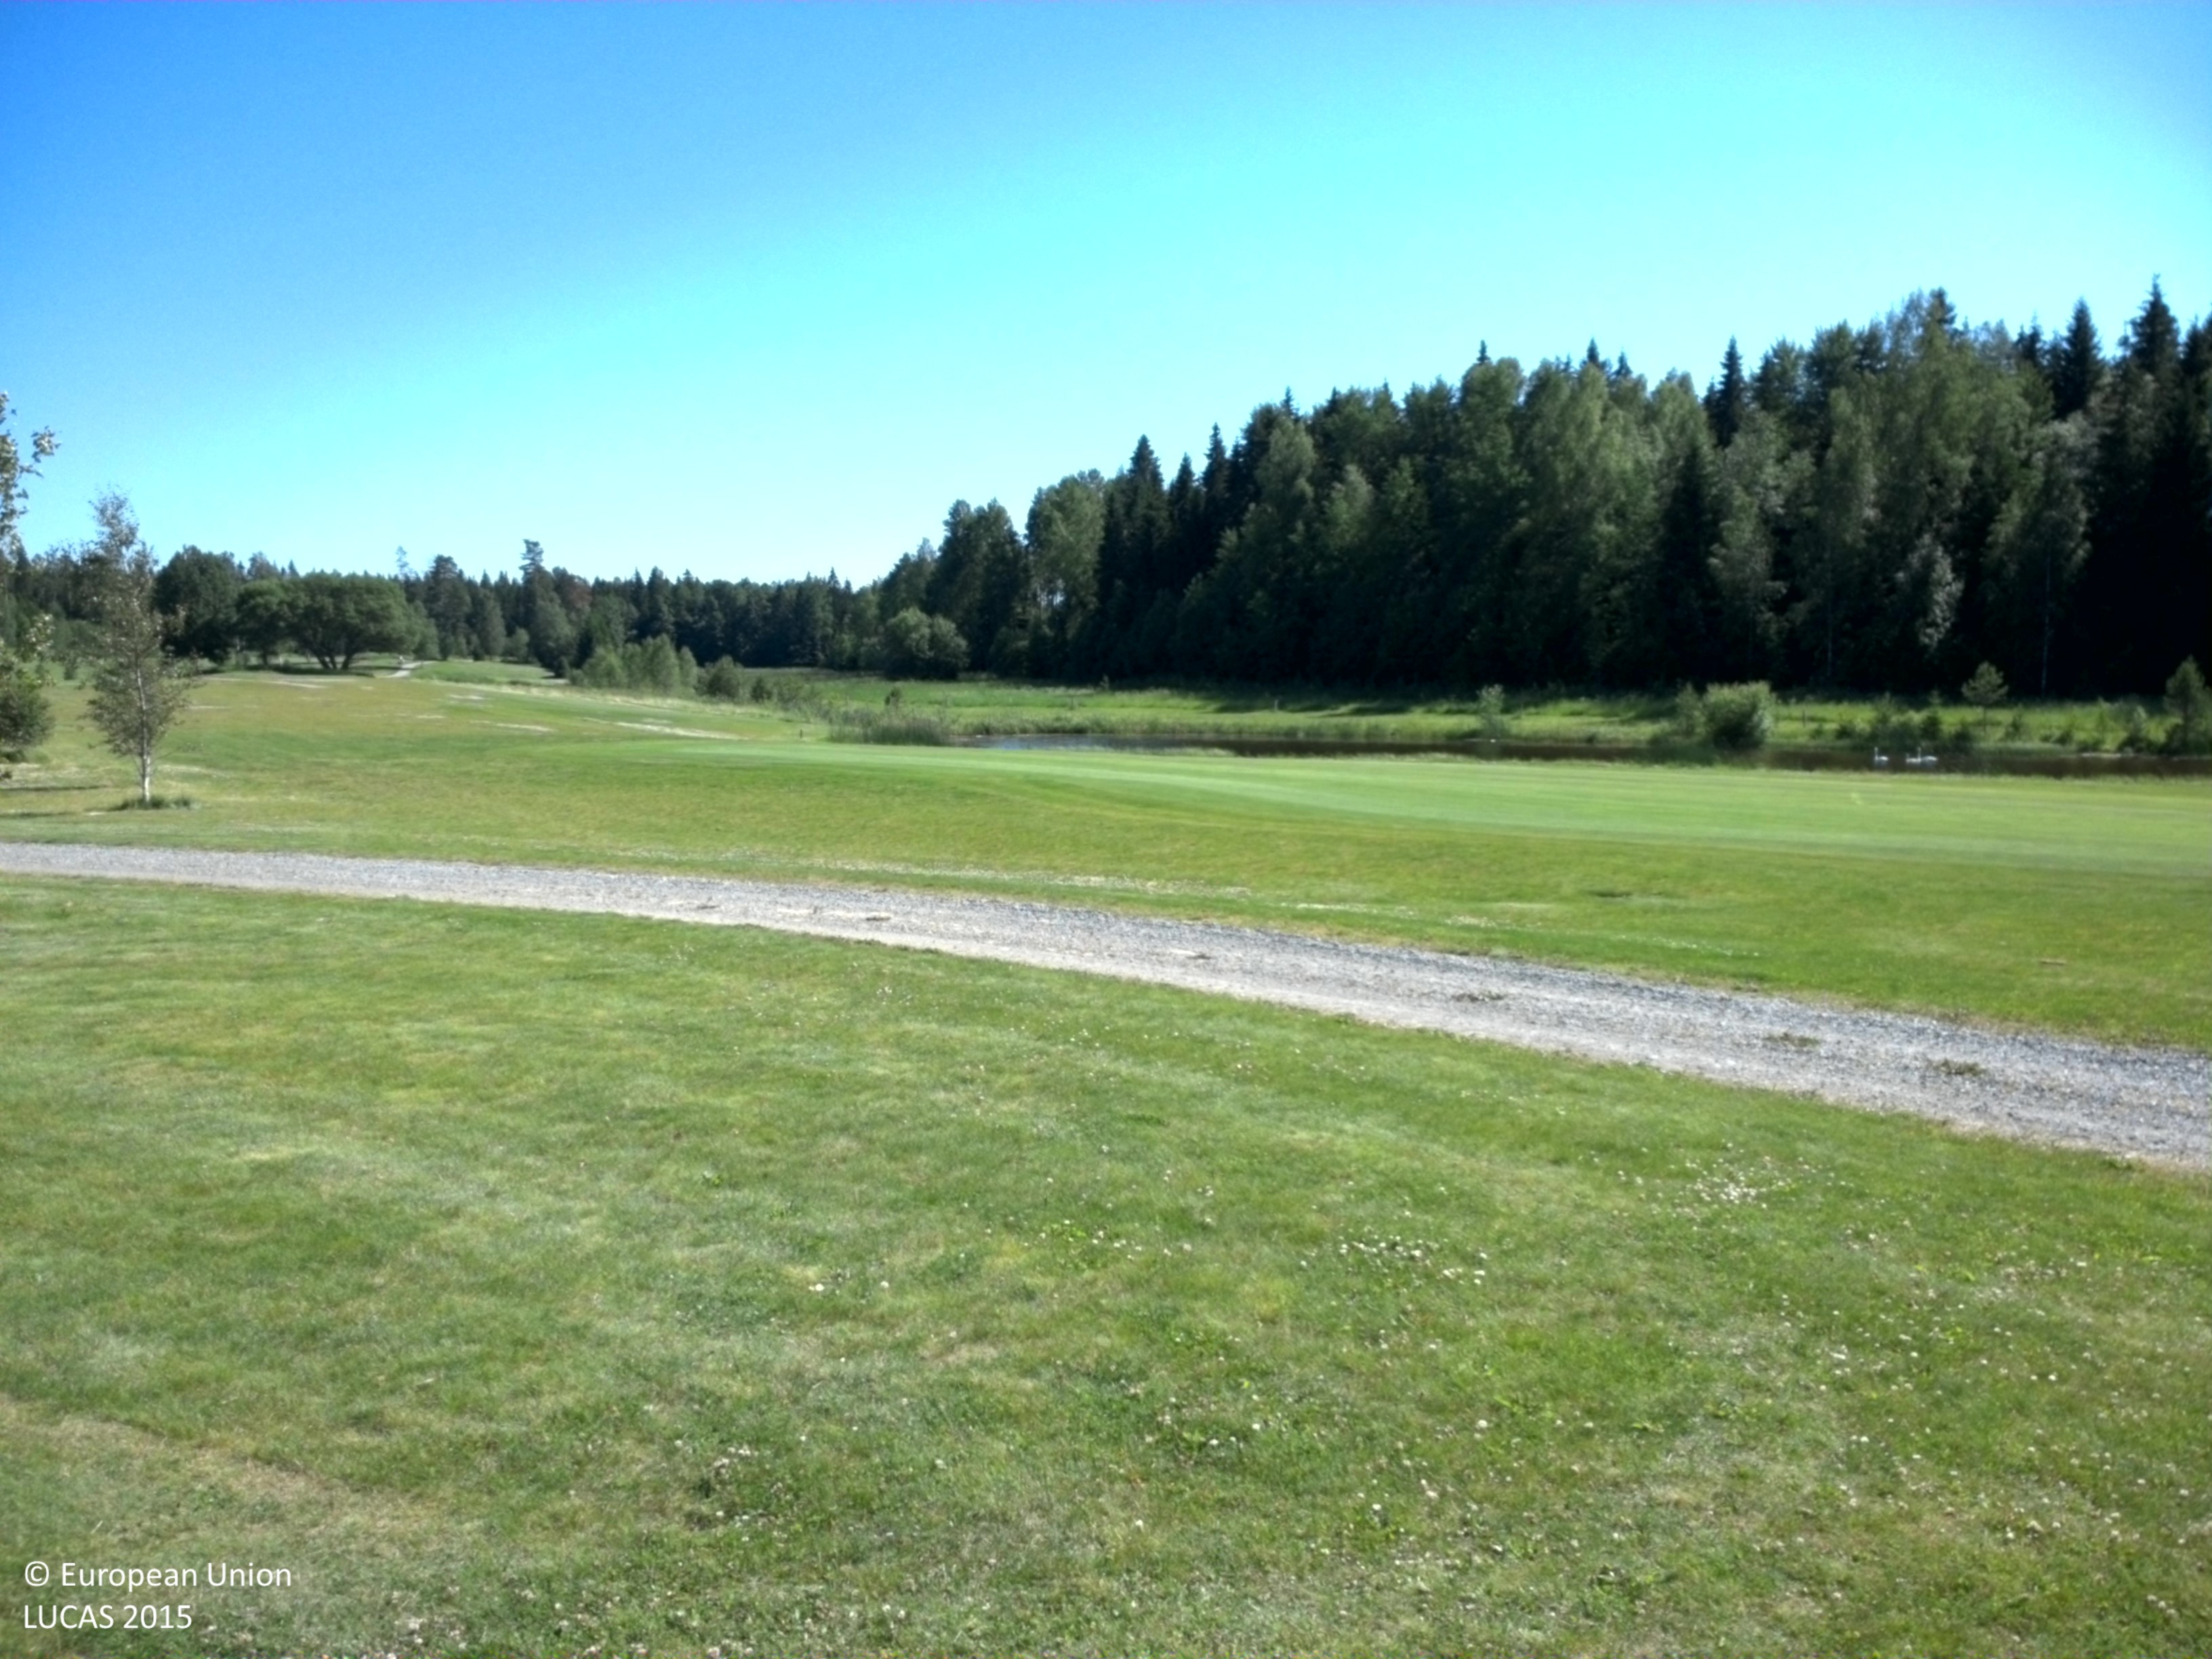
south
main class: Grassland
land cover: Grassland without tree/shrub cover
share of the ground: > 75 %
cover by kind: herbaceous plants 100 %
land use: Sport
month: July
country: SE
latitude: 59.9489
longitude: 16.7047
